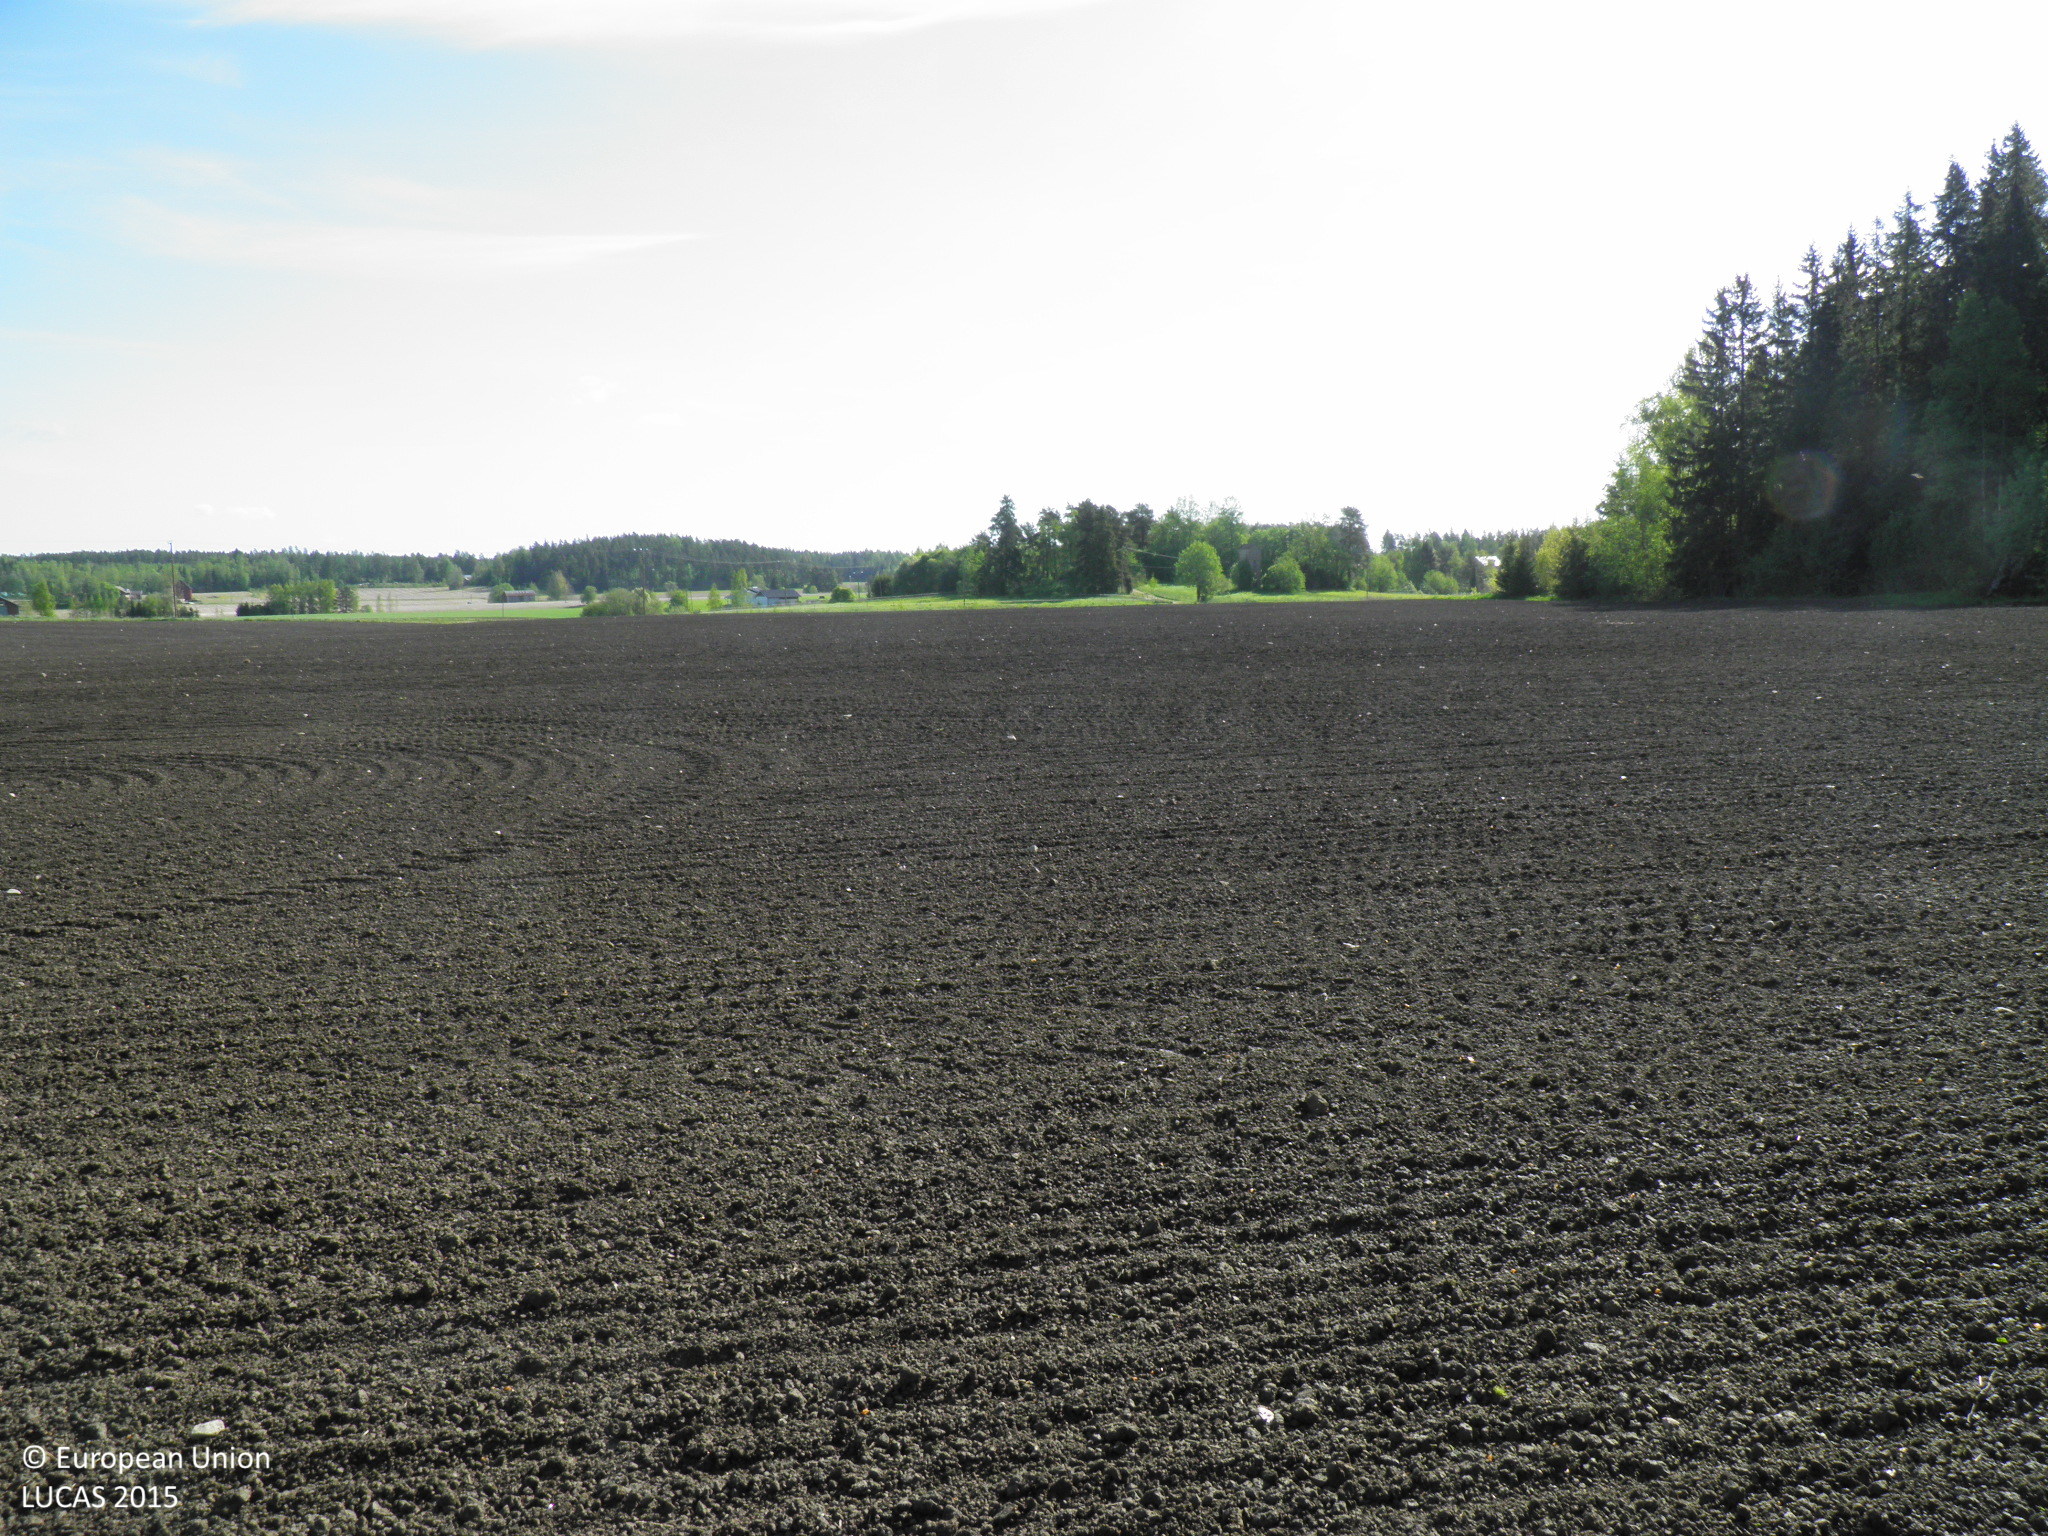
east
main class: Cropland
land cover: Common wheat
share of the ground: < 10 %
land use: Agriculture (excluding fallow land and kitchen gardens)
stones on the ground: < 10 %
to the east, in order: Common wheat; Ditches and canals; Temporary grasslands
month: June
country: FI
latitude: 60.5272
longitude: 22.5891
